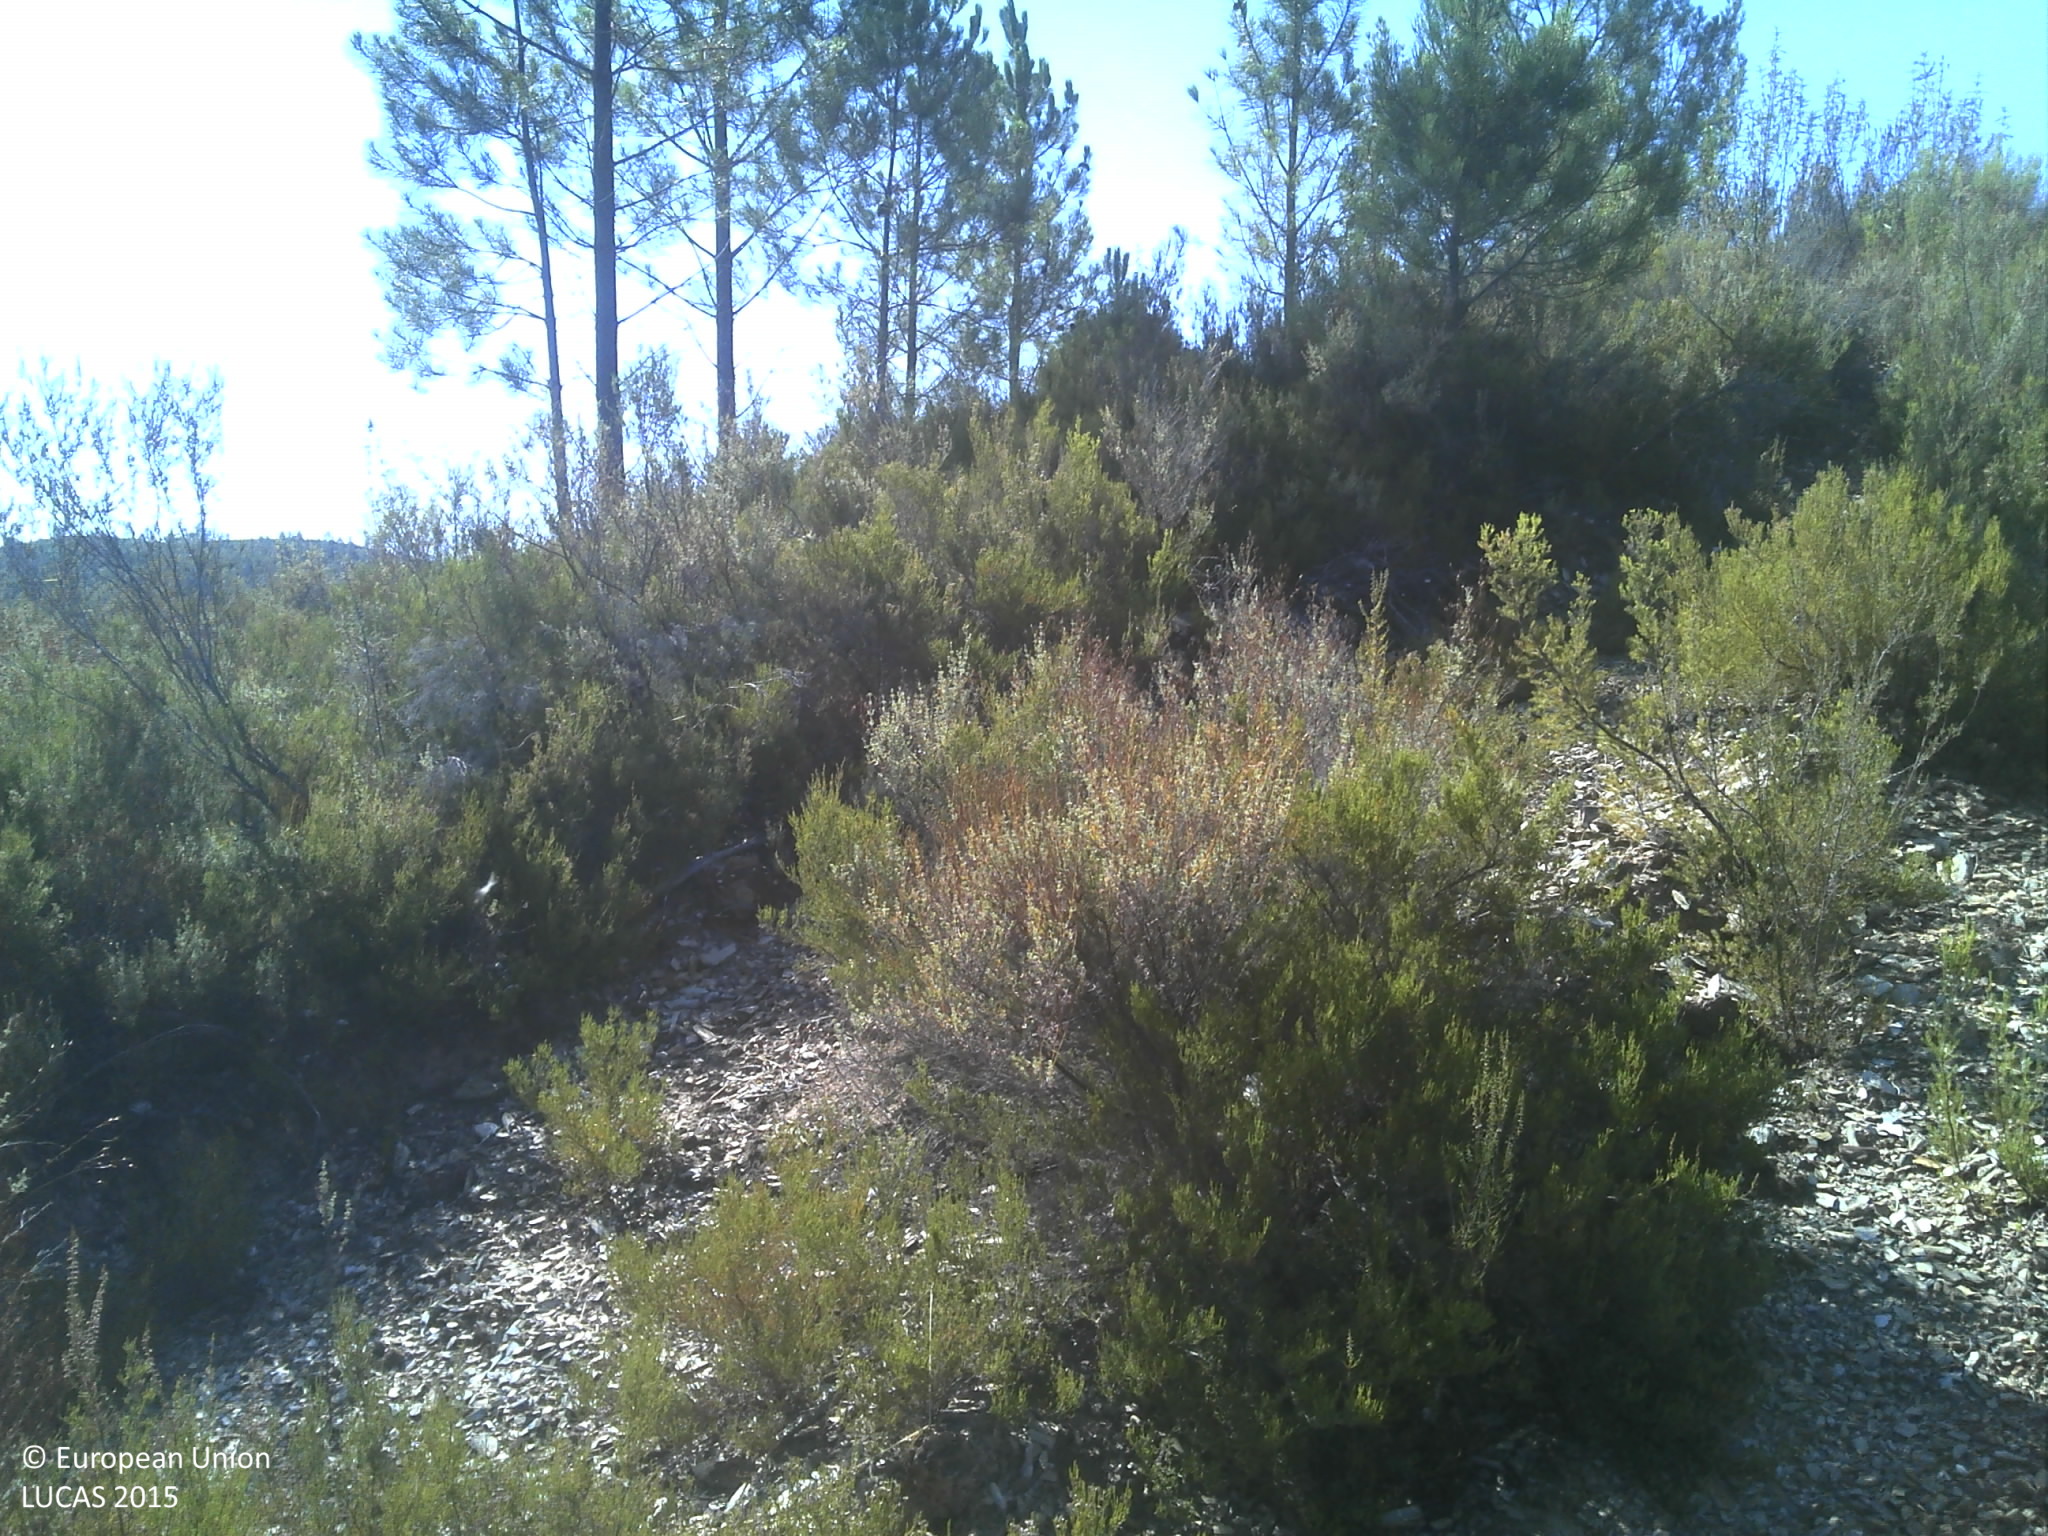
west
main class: Shrubland
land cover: Shrubland with sparse tree cover
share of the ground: 50 - 75 %
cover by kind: shrubs 75 %, unconsolidated bare surface 10 %, coniferous forest trees 5 %, herbaceous plants 5 %
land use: Forestry
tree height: < 5 m
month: July
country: PT
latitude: 39.8226
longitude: -7.6150
